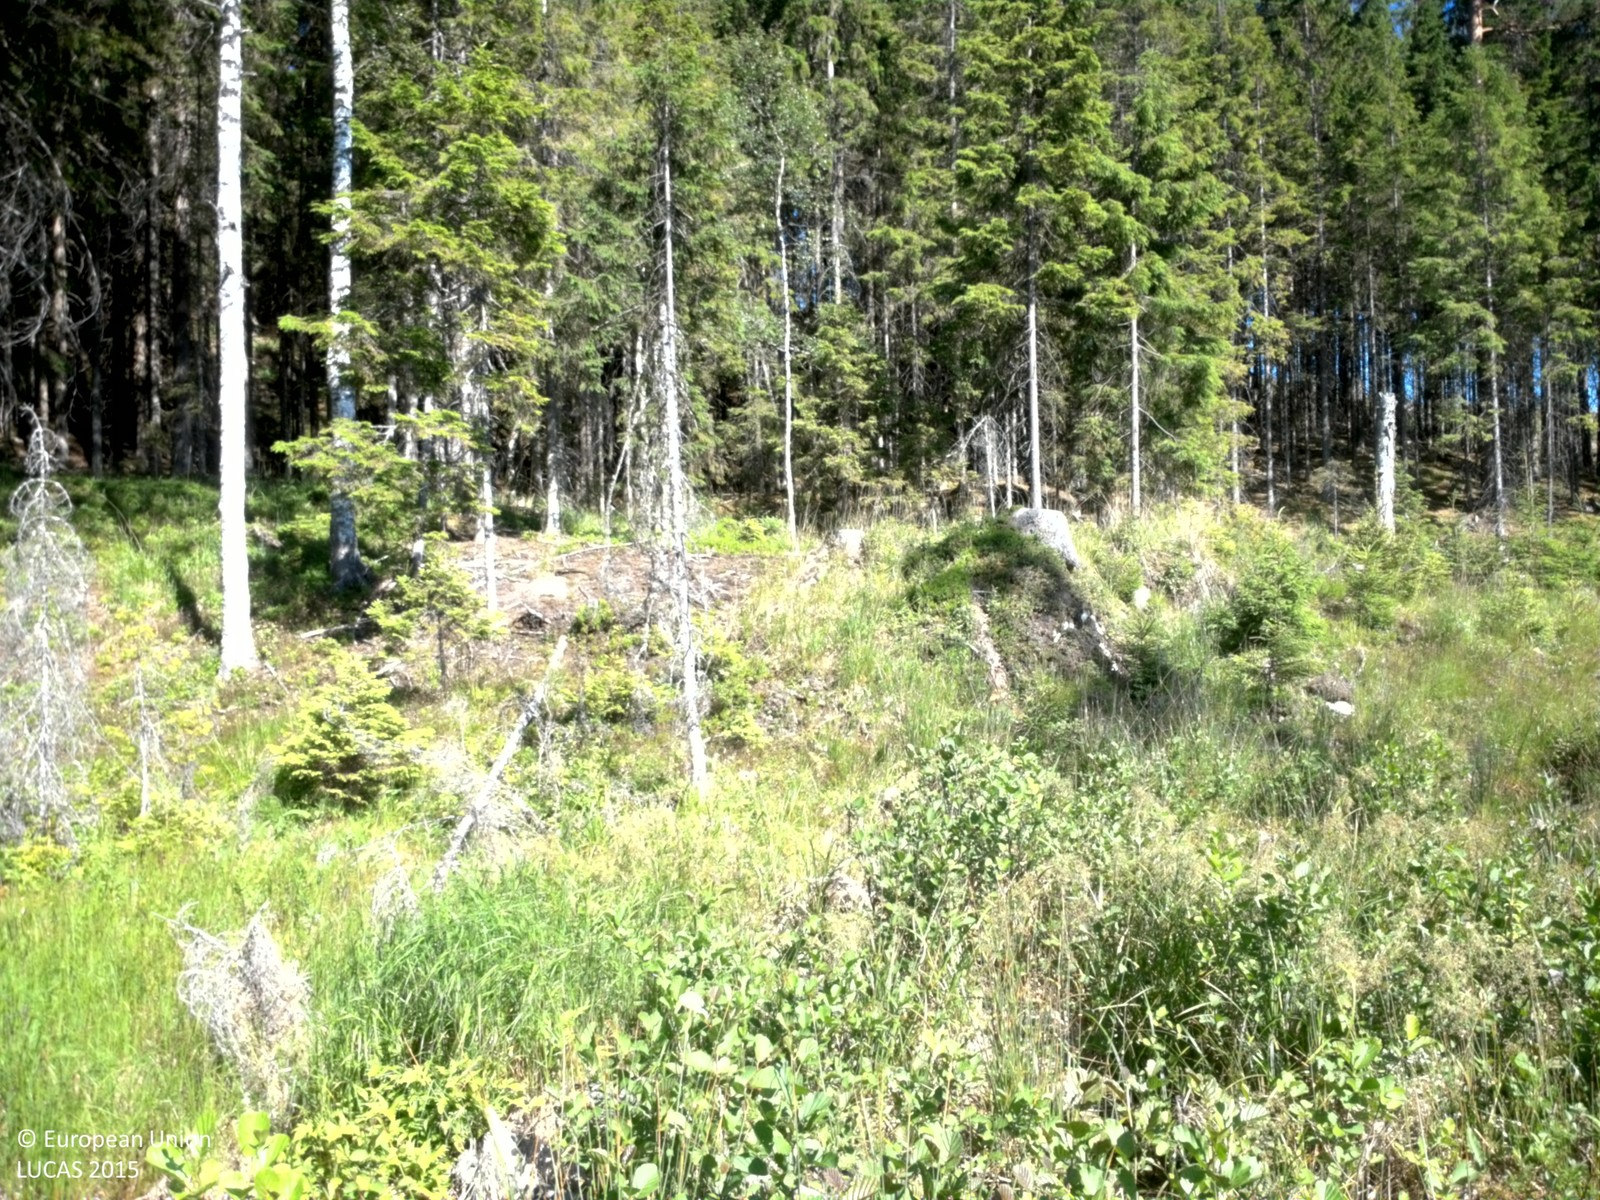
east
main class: Woodland
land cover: Spruce dominated mixed woodland
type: boreal forest
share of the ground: 25 - 50 %
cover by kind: herbaceous plants 30 %, coniferous forest trees 25 %, shrubs 25 %, broadleaved forest trees 20 %
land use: Forestry
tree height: < 5 m
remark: Clear cut
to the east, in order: Spruce dominated mixed woodland; Spruce dominated coniferous woodland; Shrubland with sparse tree cover; Spruce dominated coniferous woodland; Shrubland with sparse tree cover; Spruce dominated coniferous woodland
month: July
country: SE
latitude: 59.8231
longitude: 12.0808
